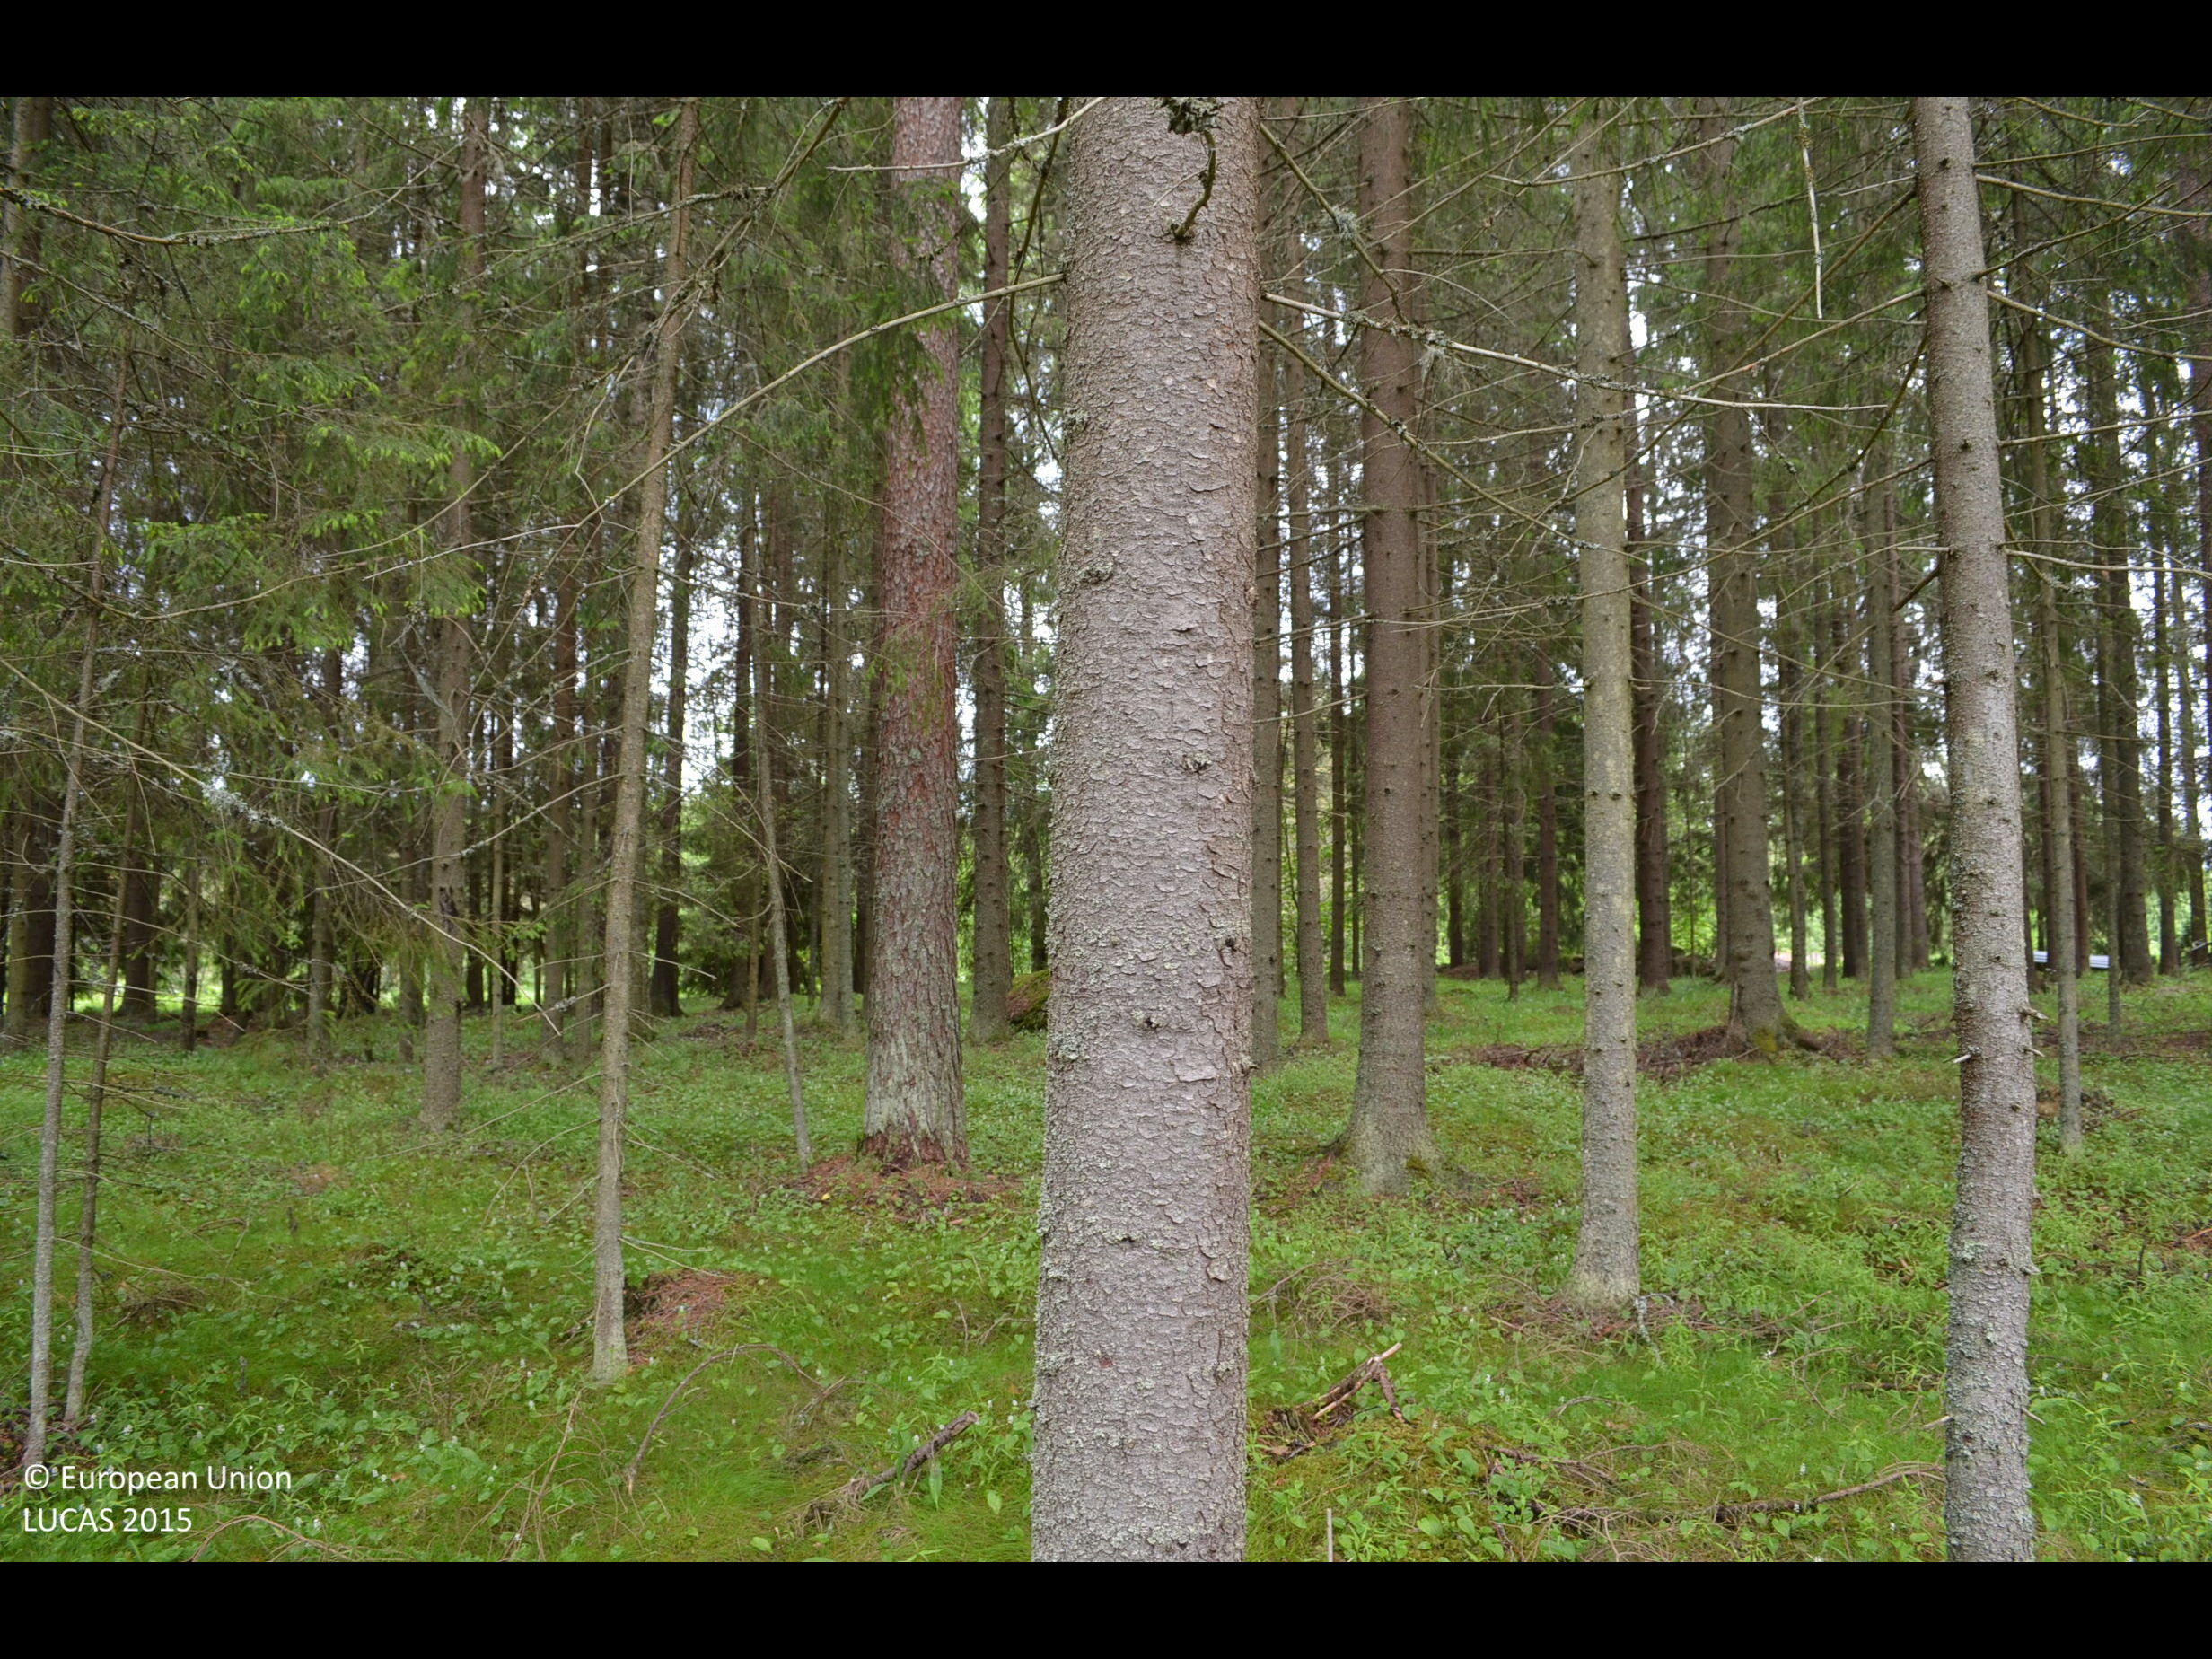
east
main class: Woodland
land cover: Other coniferous woodland
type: boreal forest
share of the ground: > 75 %
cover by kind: coniferous forest trees 85 %, broadleaved forest trees 5 %, herbaceous plants 5 %, lichens and mosses 5 %
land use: Forestry
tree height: > 5 m
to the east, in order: Other coniferous woodland; Grassland without tree/shrub cover; Ditches and canals; Grass margins; Paved roads, cycling and walking lanes; Grass margins; Ditches and canals; Temporary grasslands; Electric lines; Temporary grasslands; Ditches and canals; Broadleaved woodland; Spruce dominated coniferous woodland
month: June
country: FI
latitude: 61.7751
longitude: 23.3617
